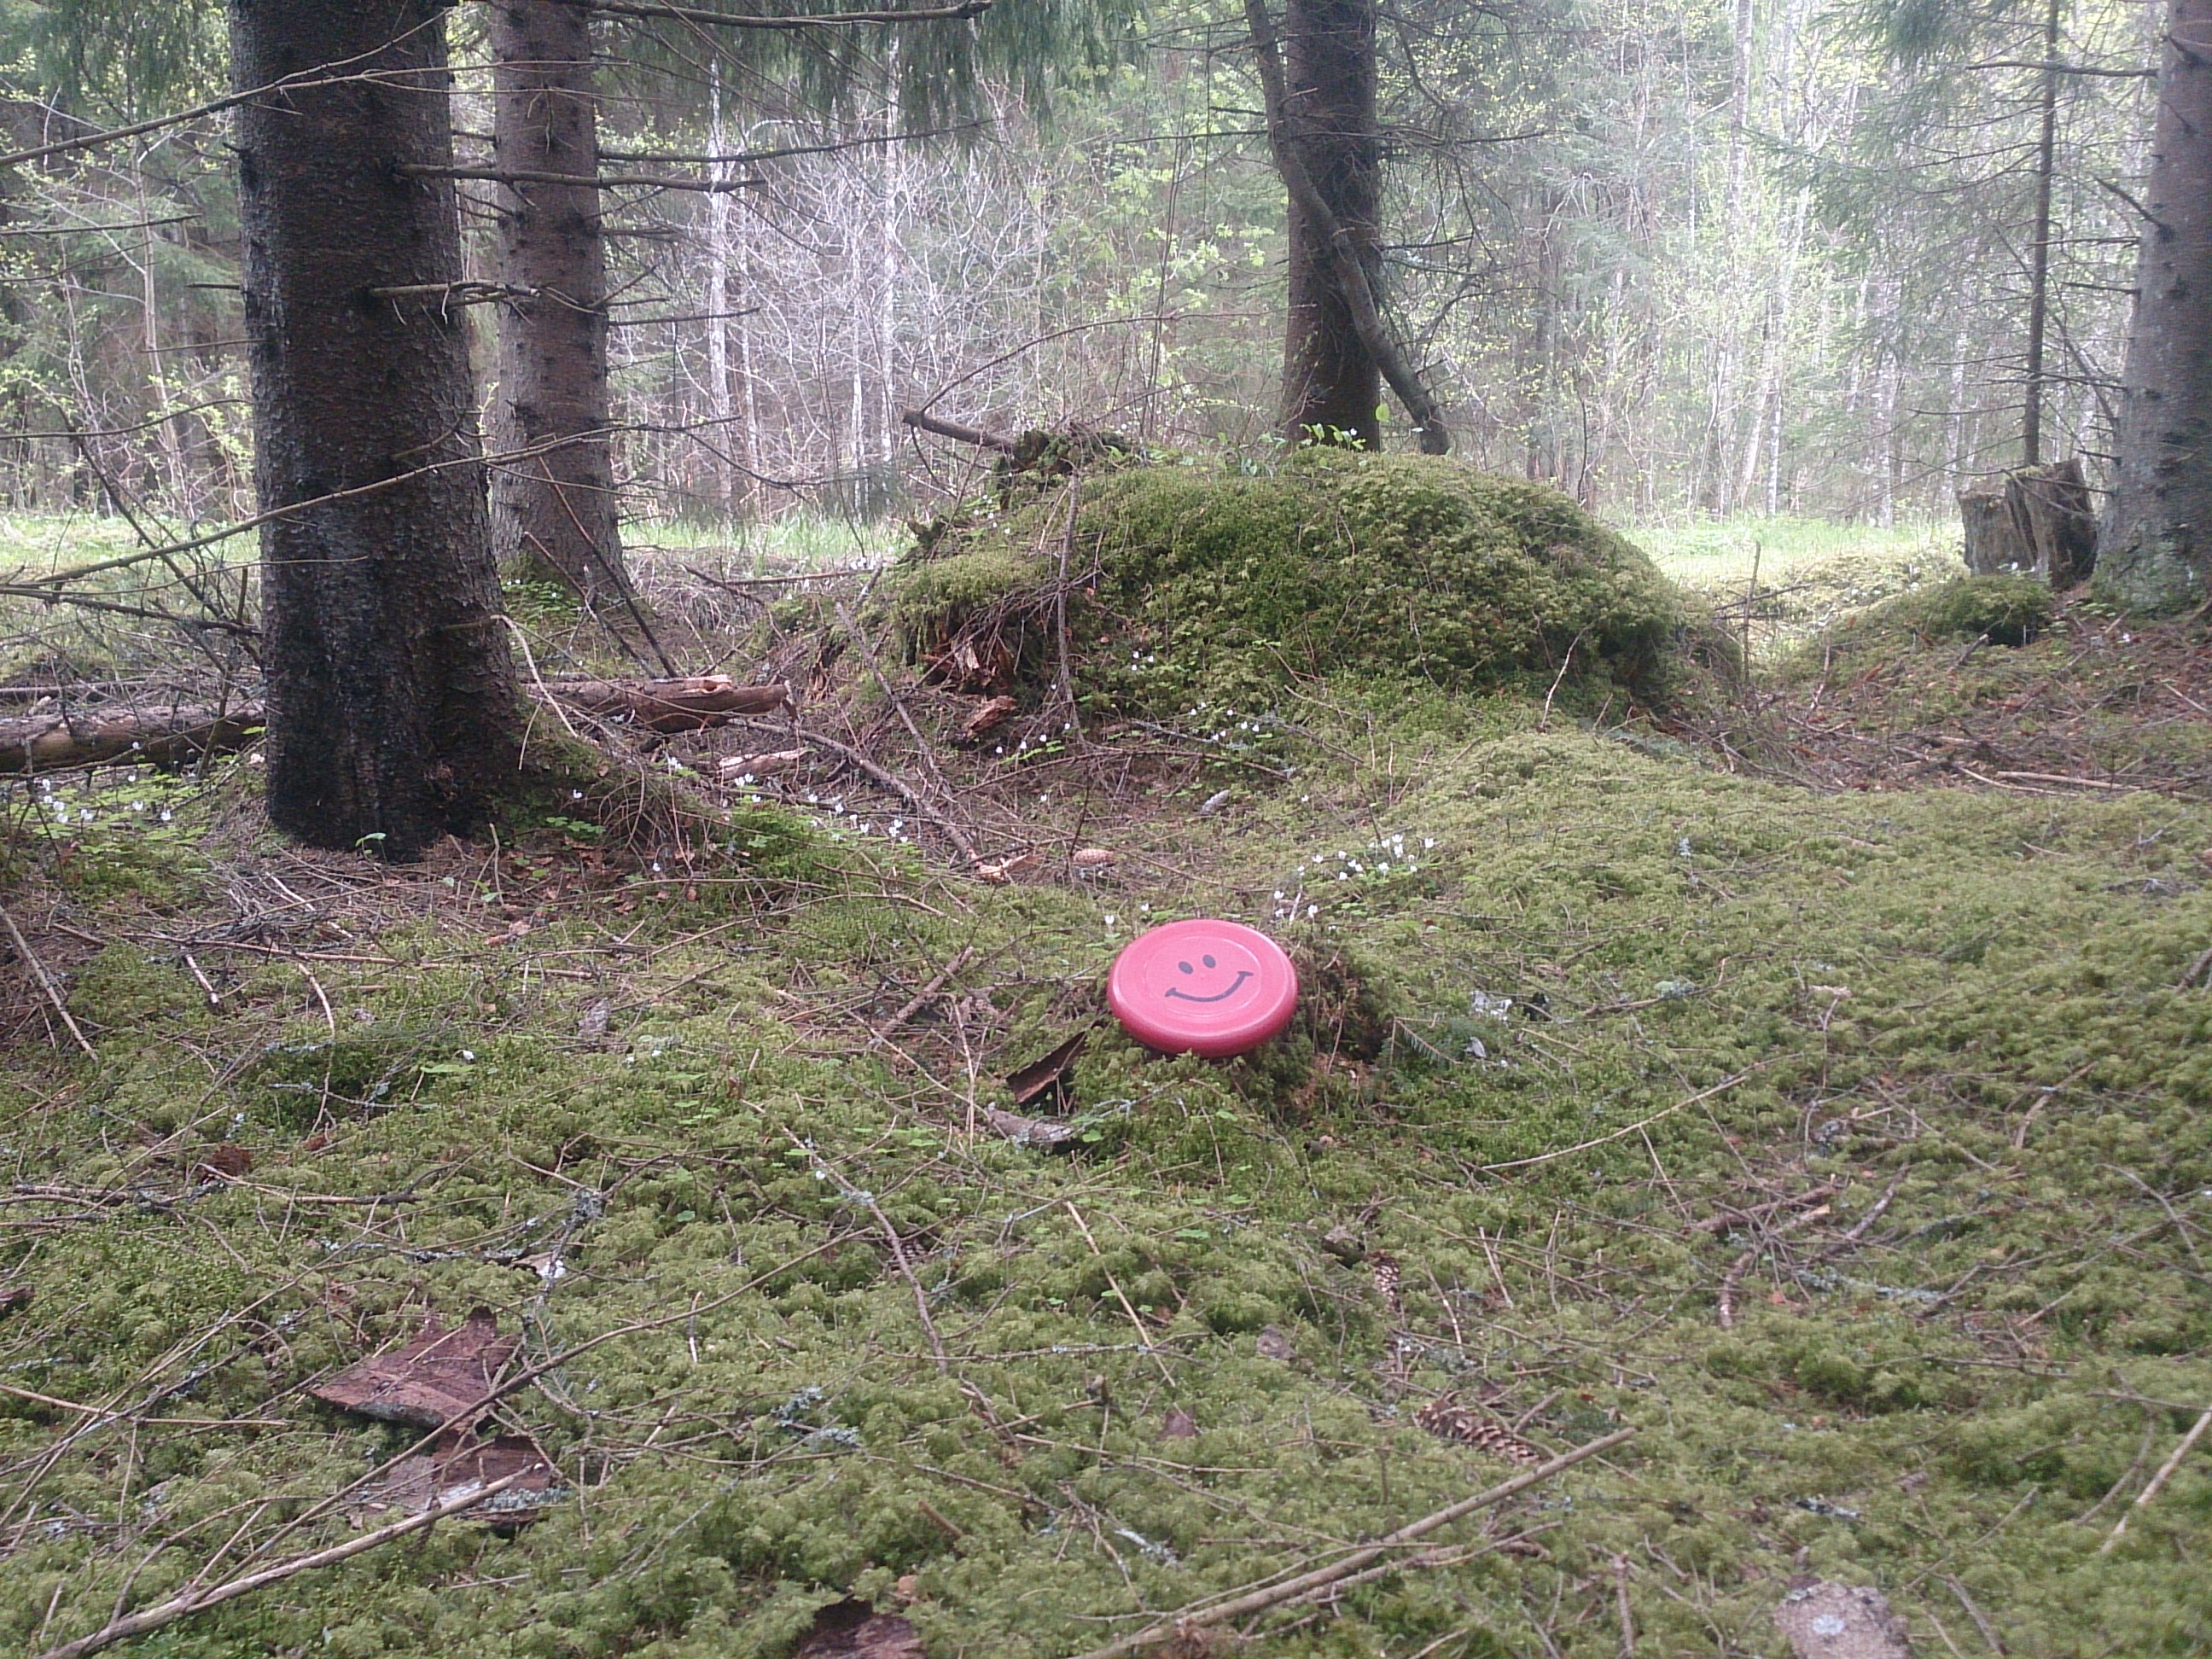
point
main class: Woodland
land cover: Spruce dominated coniferous woodland
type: hemiboreal forest and nemoral coniferous forest and mixed broadleaved-coniferous forest
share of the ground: > 75 %
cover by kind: coniferous forest trees 100 %
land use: Forestry
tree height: > 5 m
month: May
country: LV
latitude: 56.7041
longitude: 24.0835
